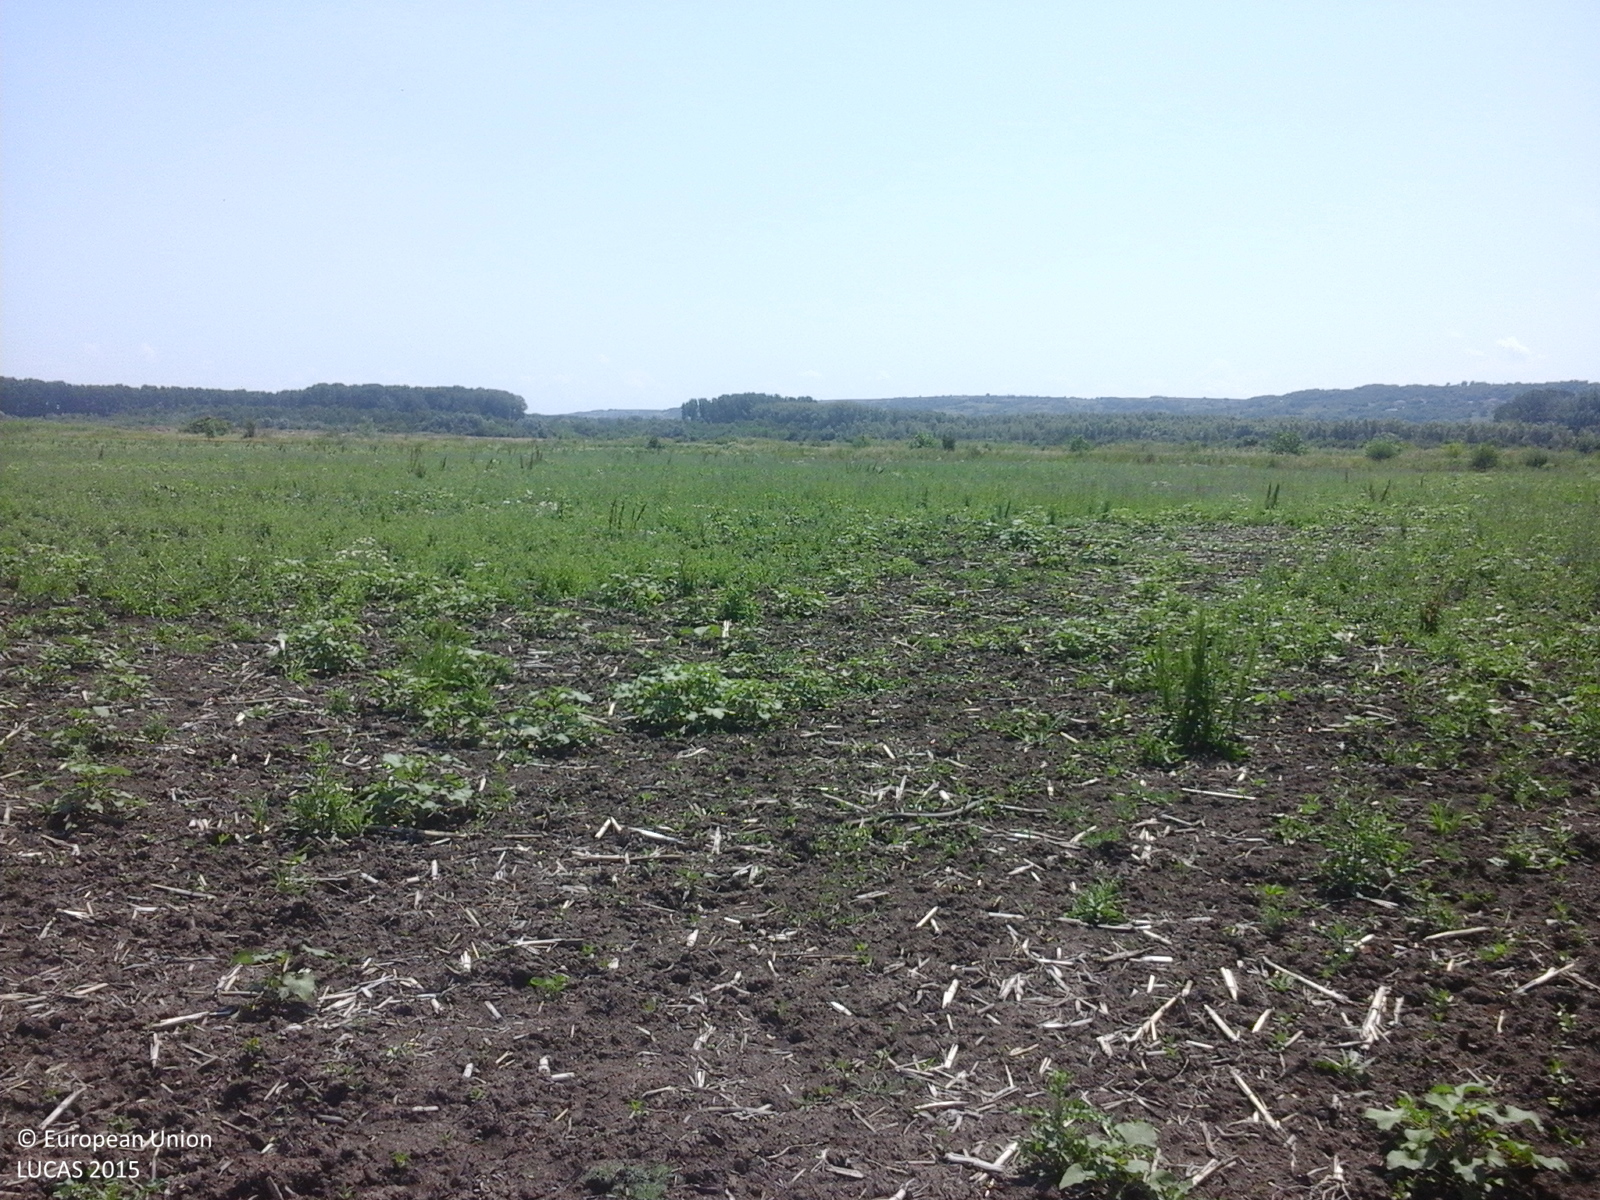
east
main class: Cropland
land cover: Soya
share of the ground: < 10 %
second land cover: Spontaneously vegetated surfaces
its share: 25 - 50 %
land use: Agriculture (excluding fallow land and kitchen gardens)
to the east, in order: Soya; Spontaneously vegetated surfaces; Grass margins; Ditches and canals; Single bushes/trees; Grass margins; Soya
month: June
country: RO
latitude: 44.0674
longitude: 26.6064
